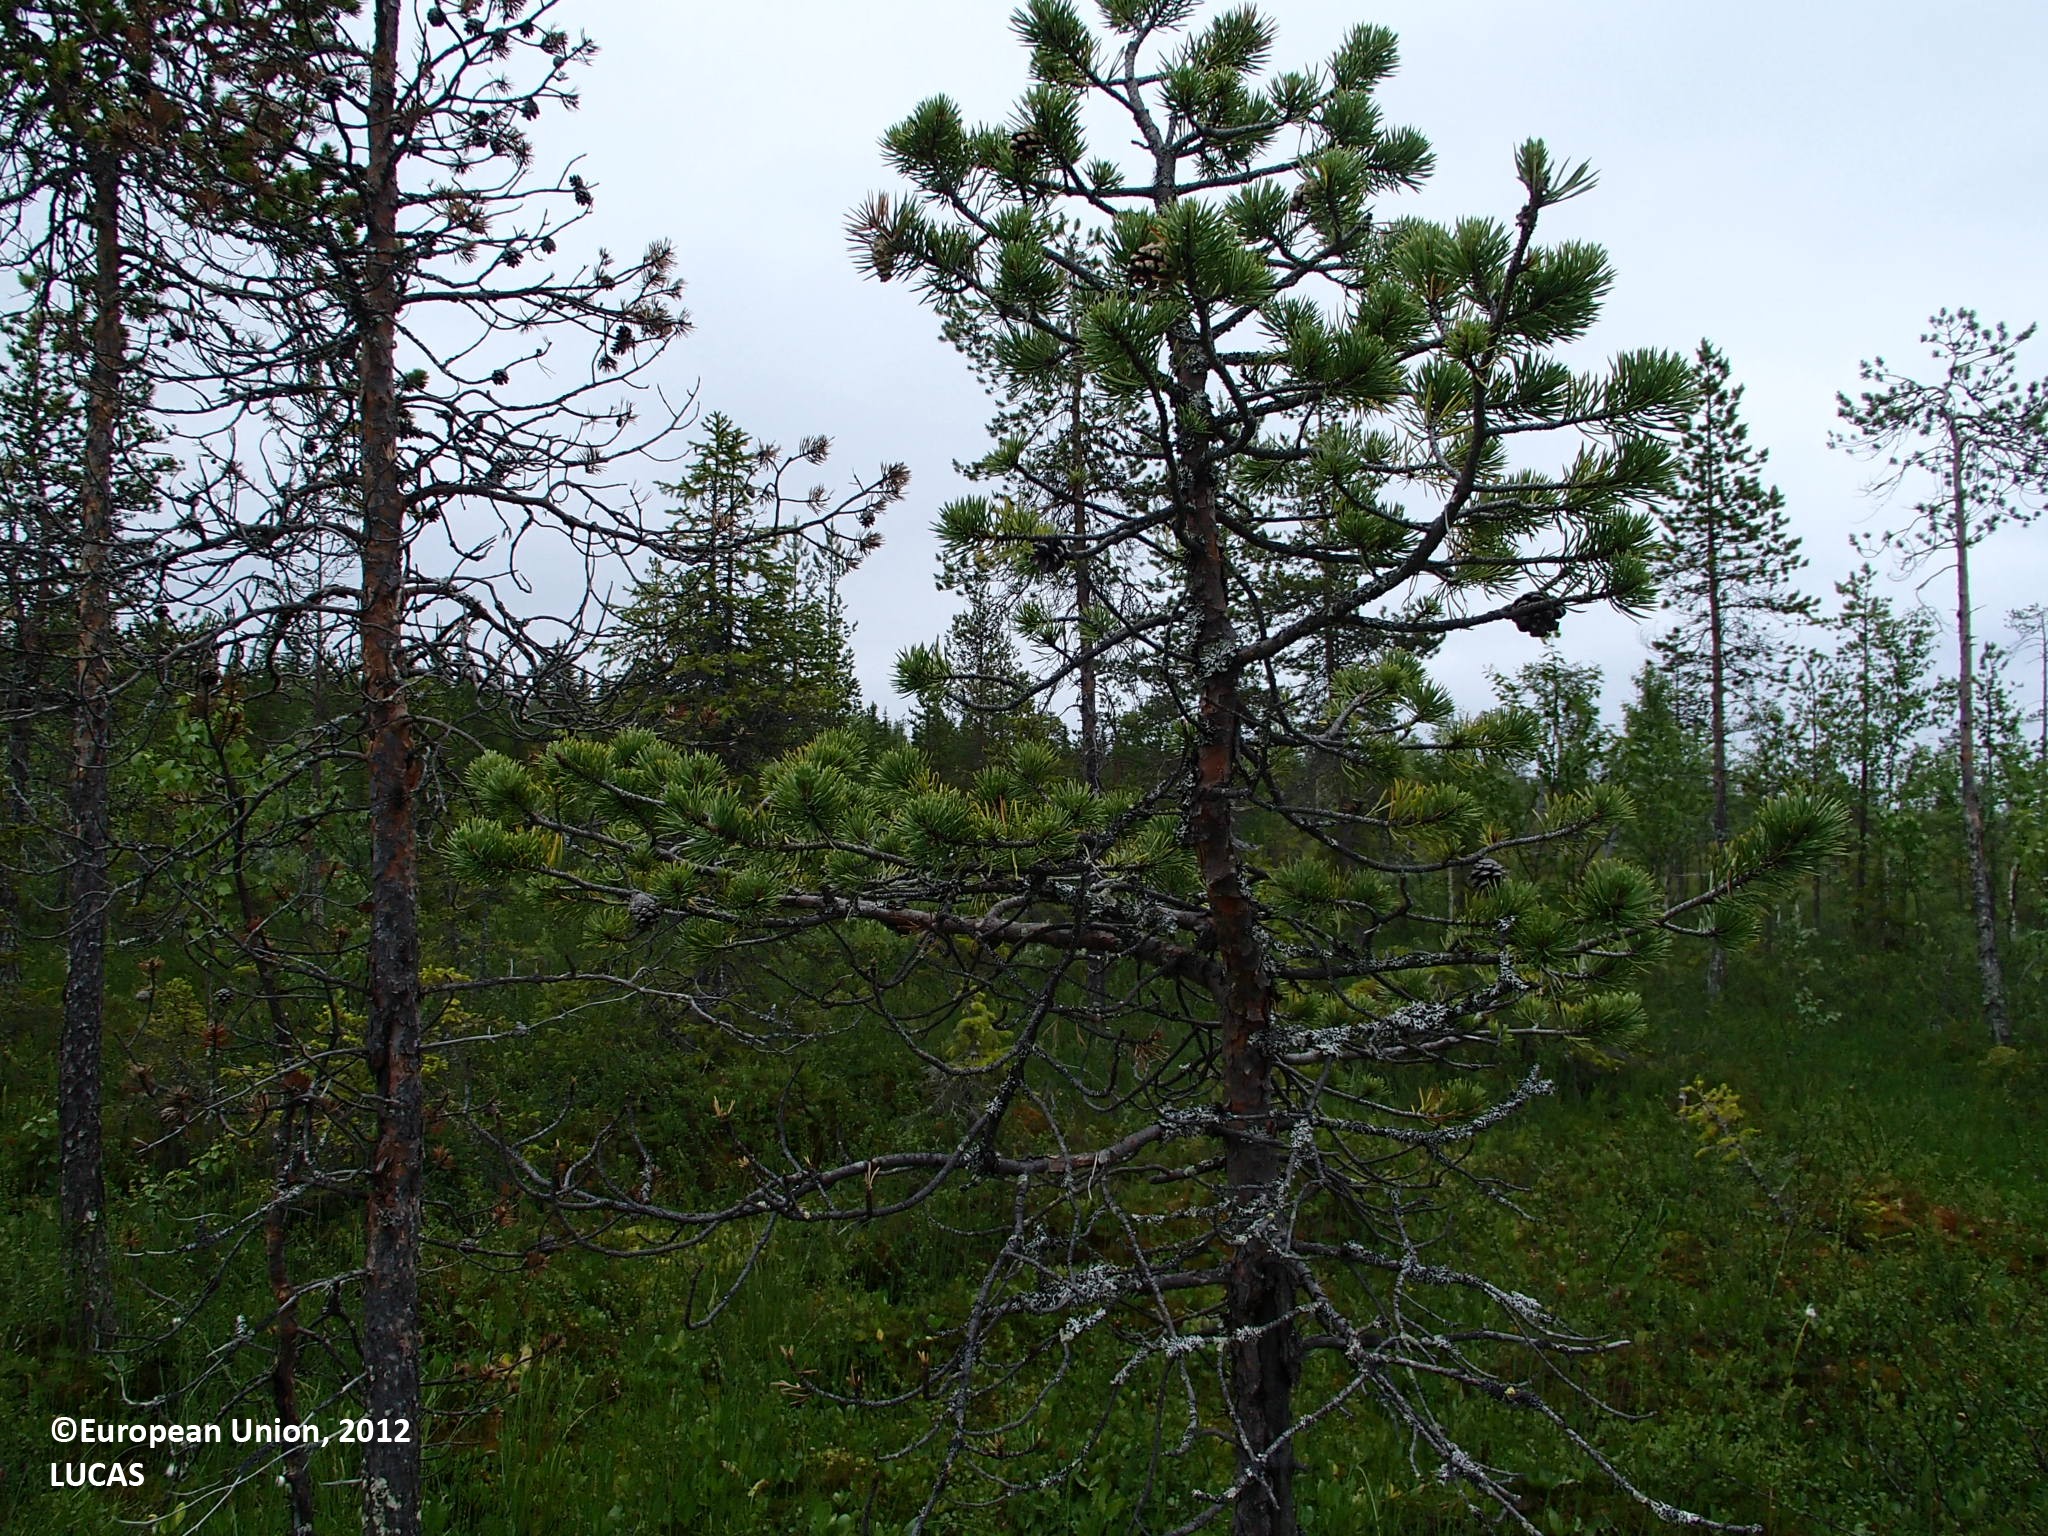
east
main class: Woodland
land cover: Pine dominated coniferous woodland
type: boreal forest
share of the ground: 10 - 25 %
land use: Forestry
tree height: > 5 m
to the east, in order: Pine dominated coniferous woodland; Peatbogs; Other coniferous woodland; Other mixed woodland; Temporary grasslands; Other mixed woodland
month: July
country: FI
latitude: 67.3488
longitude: 25.9534
